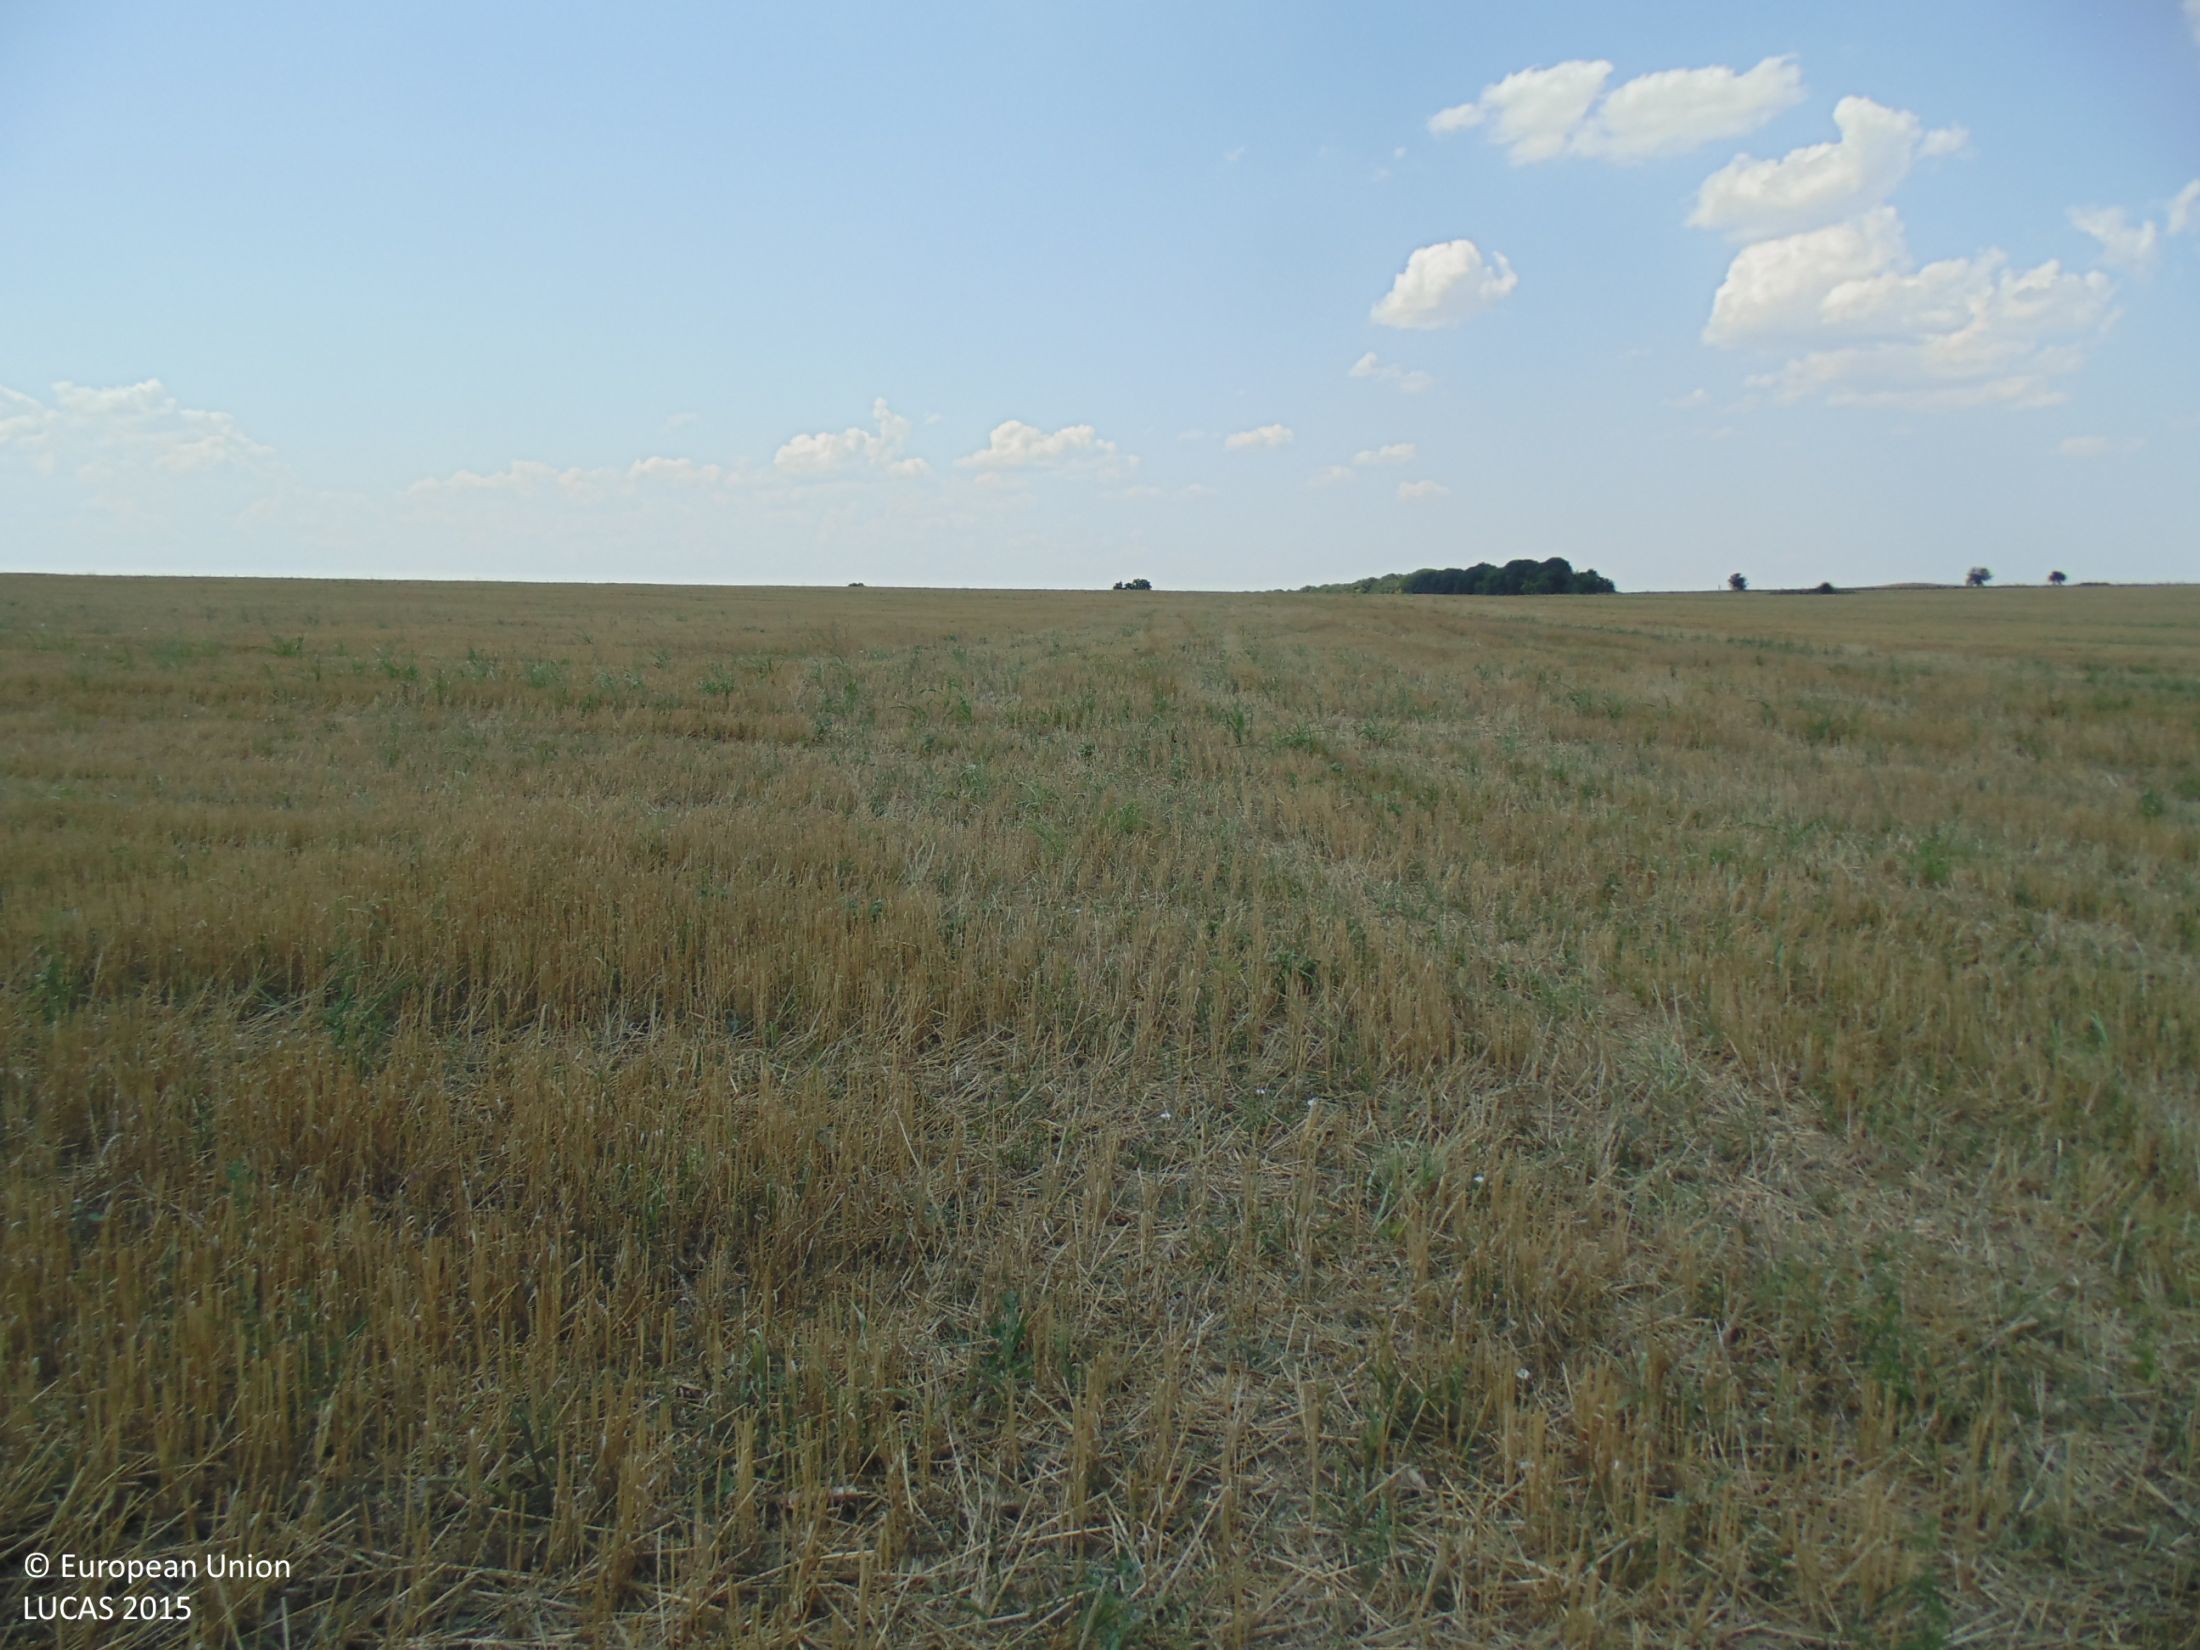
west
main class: Cropland
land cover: Common wheat
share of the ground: > 75 %
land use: Agriculture (excluding fallow land and kitchen gardens)
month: August
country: BG
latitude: 43.7771
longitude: 27.5679
